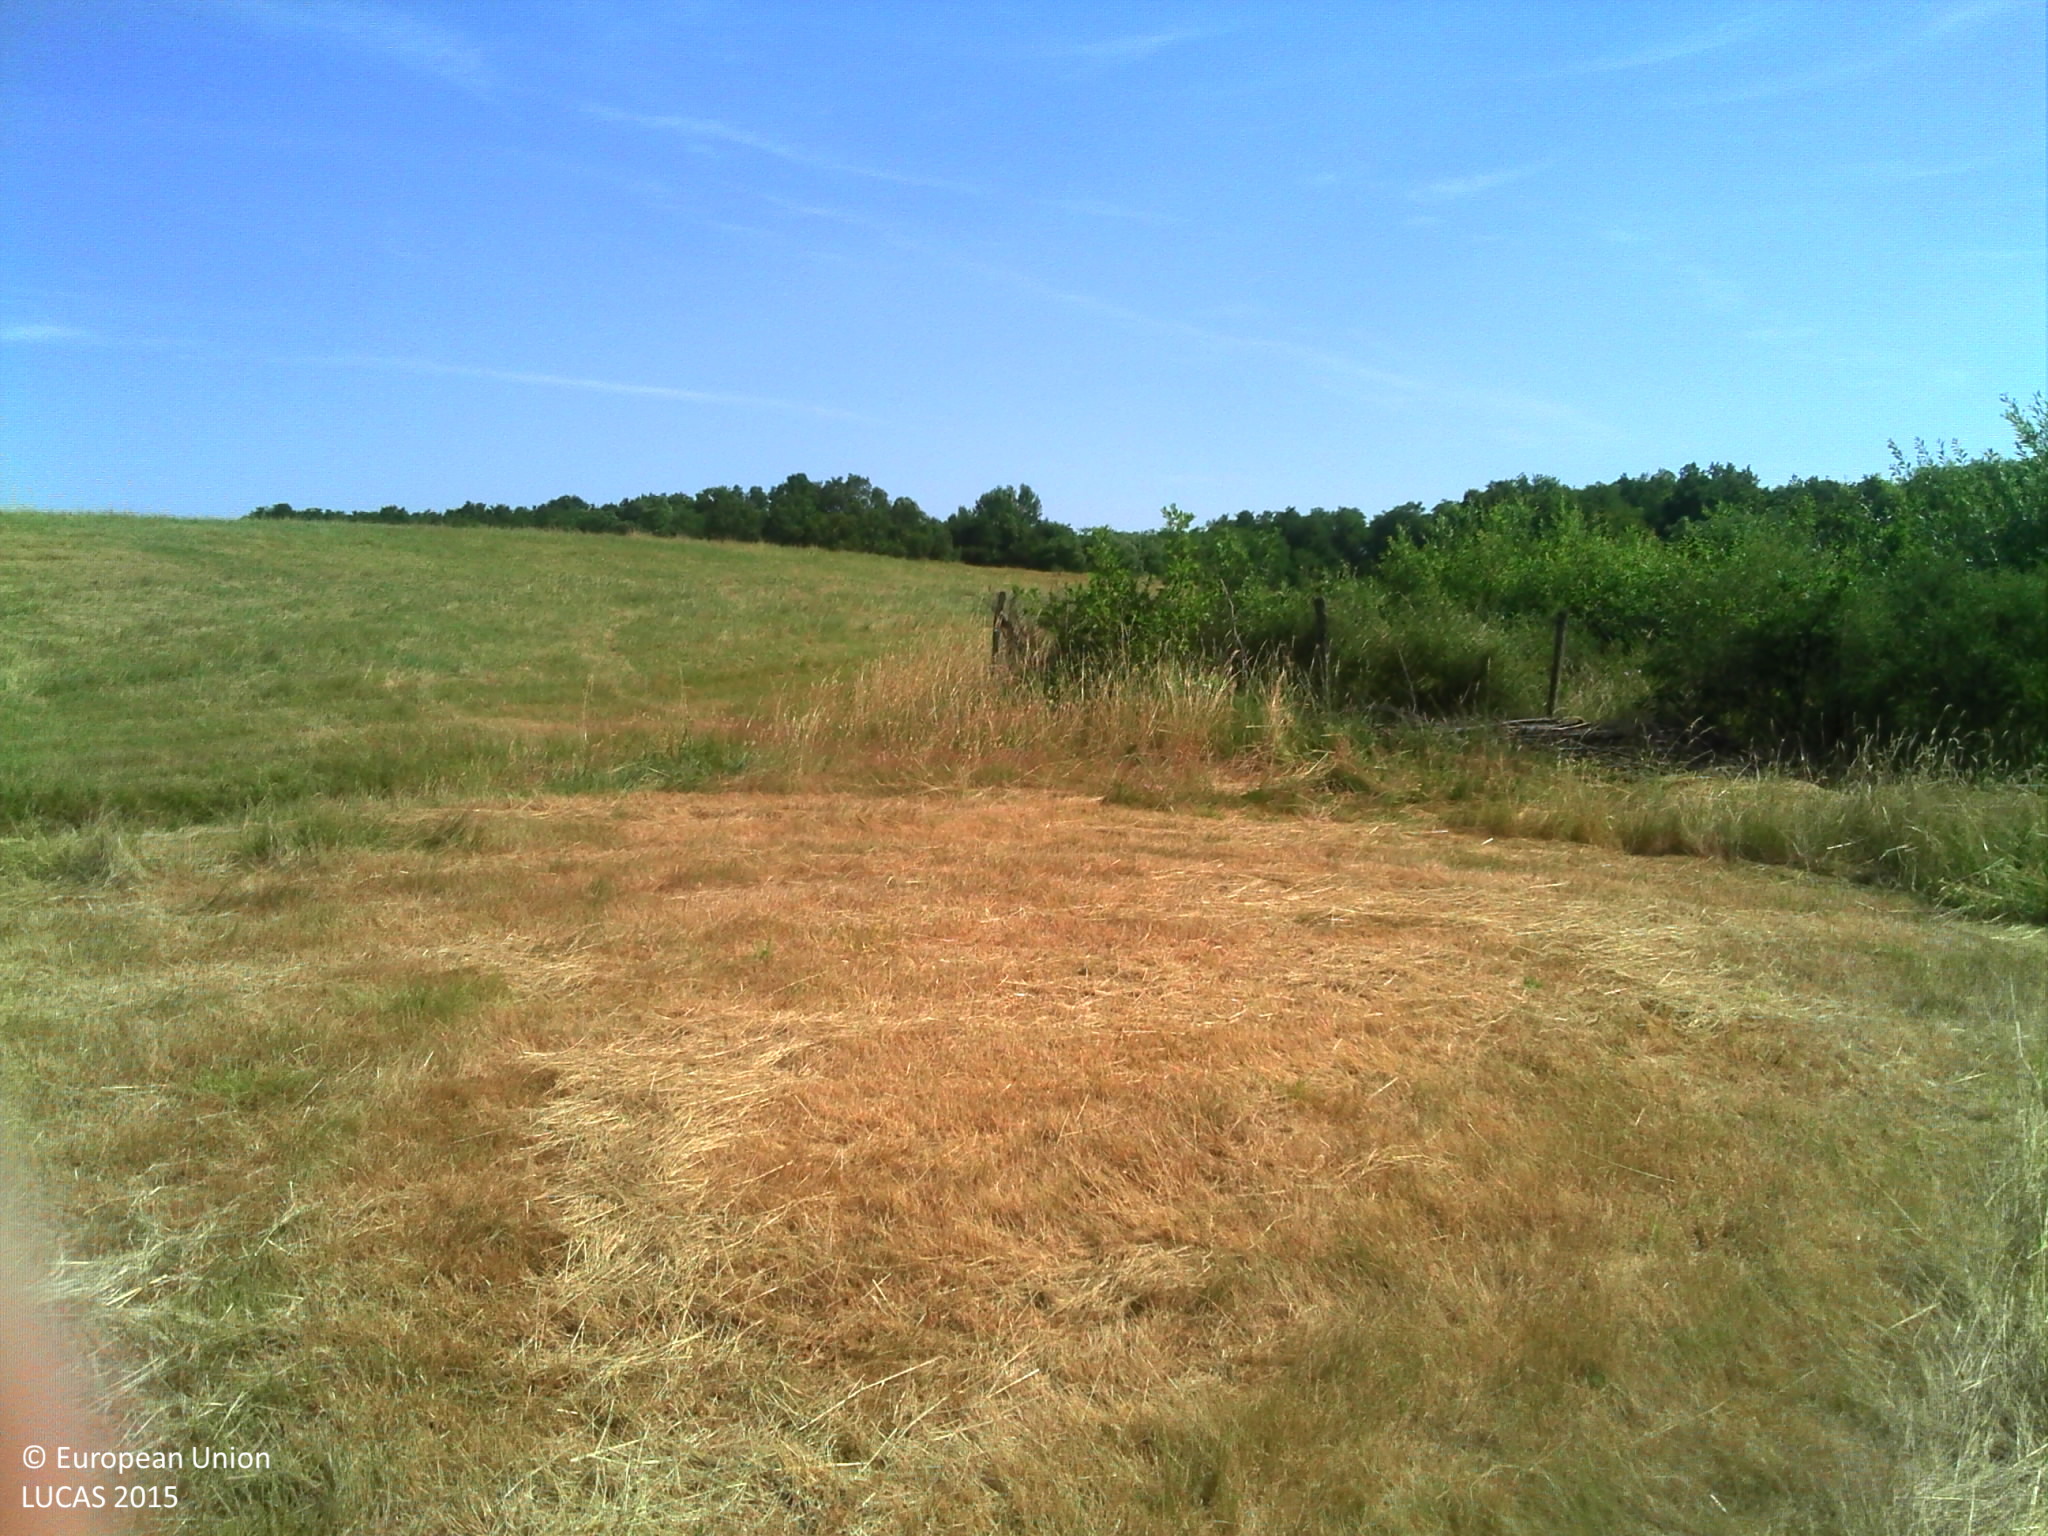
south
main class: Grassland
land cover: Grassland without tree/shrub cover
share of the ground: > 75 %
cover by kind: herbaceous plants 100 %
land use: Air transport
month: June
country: FR
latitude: 47.3629
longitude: 2.9104
